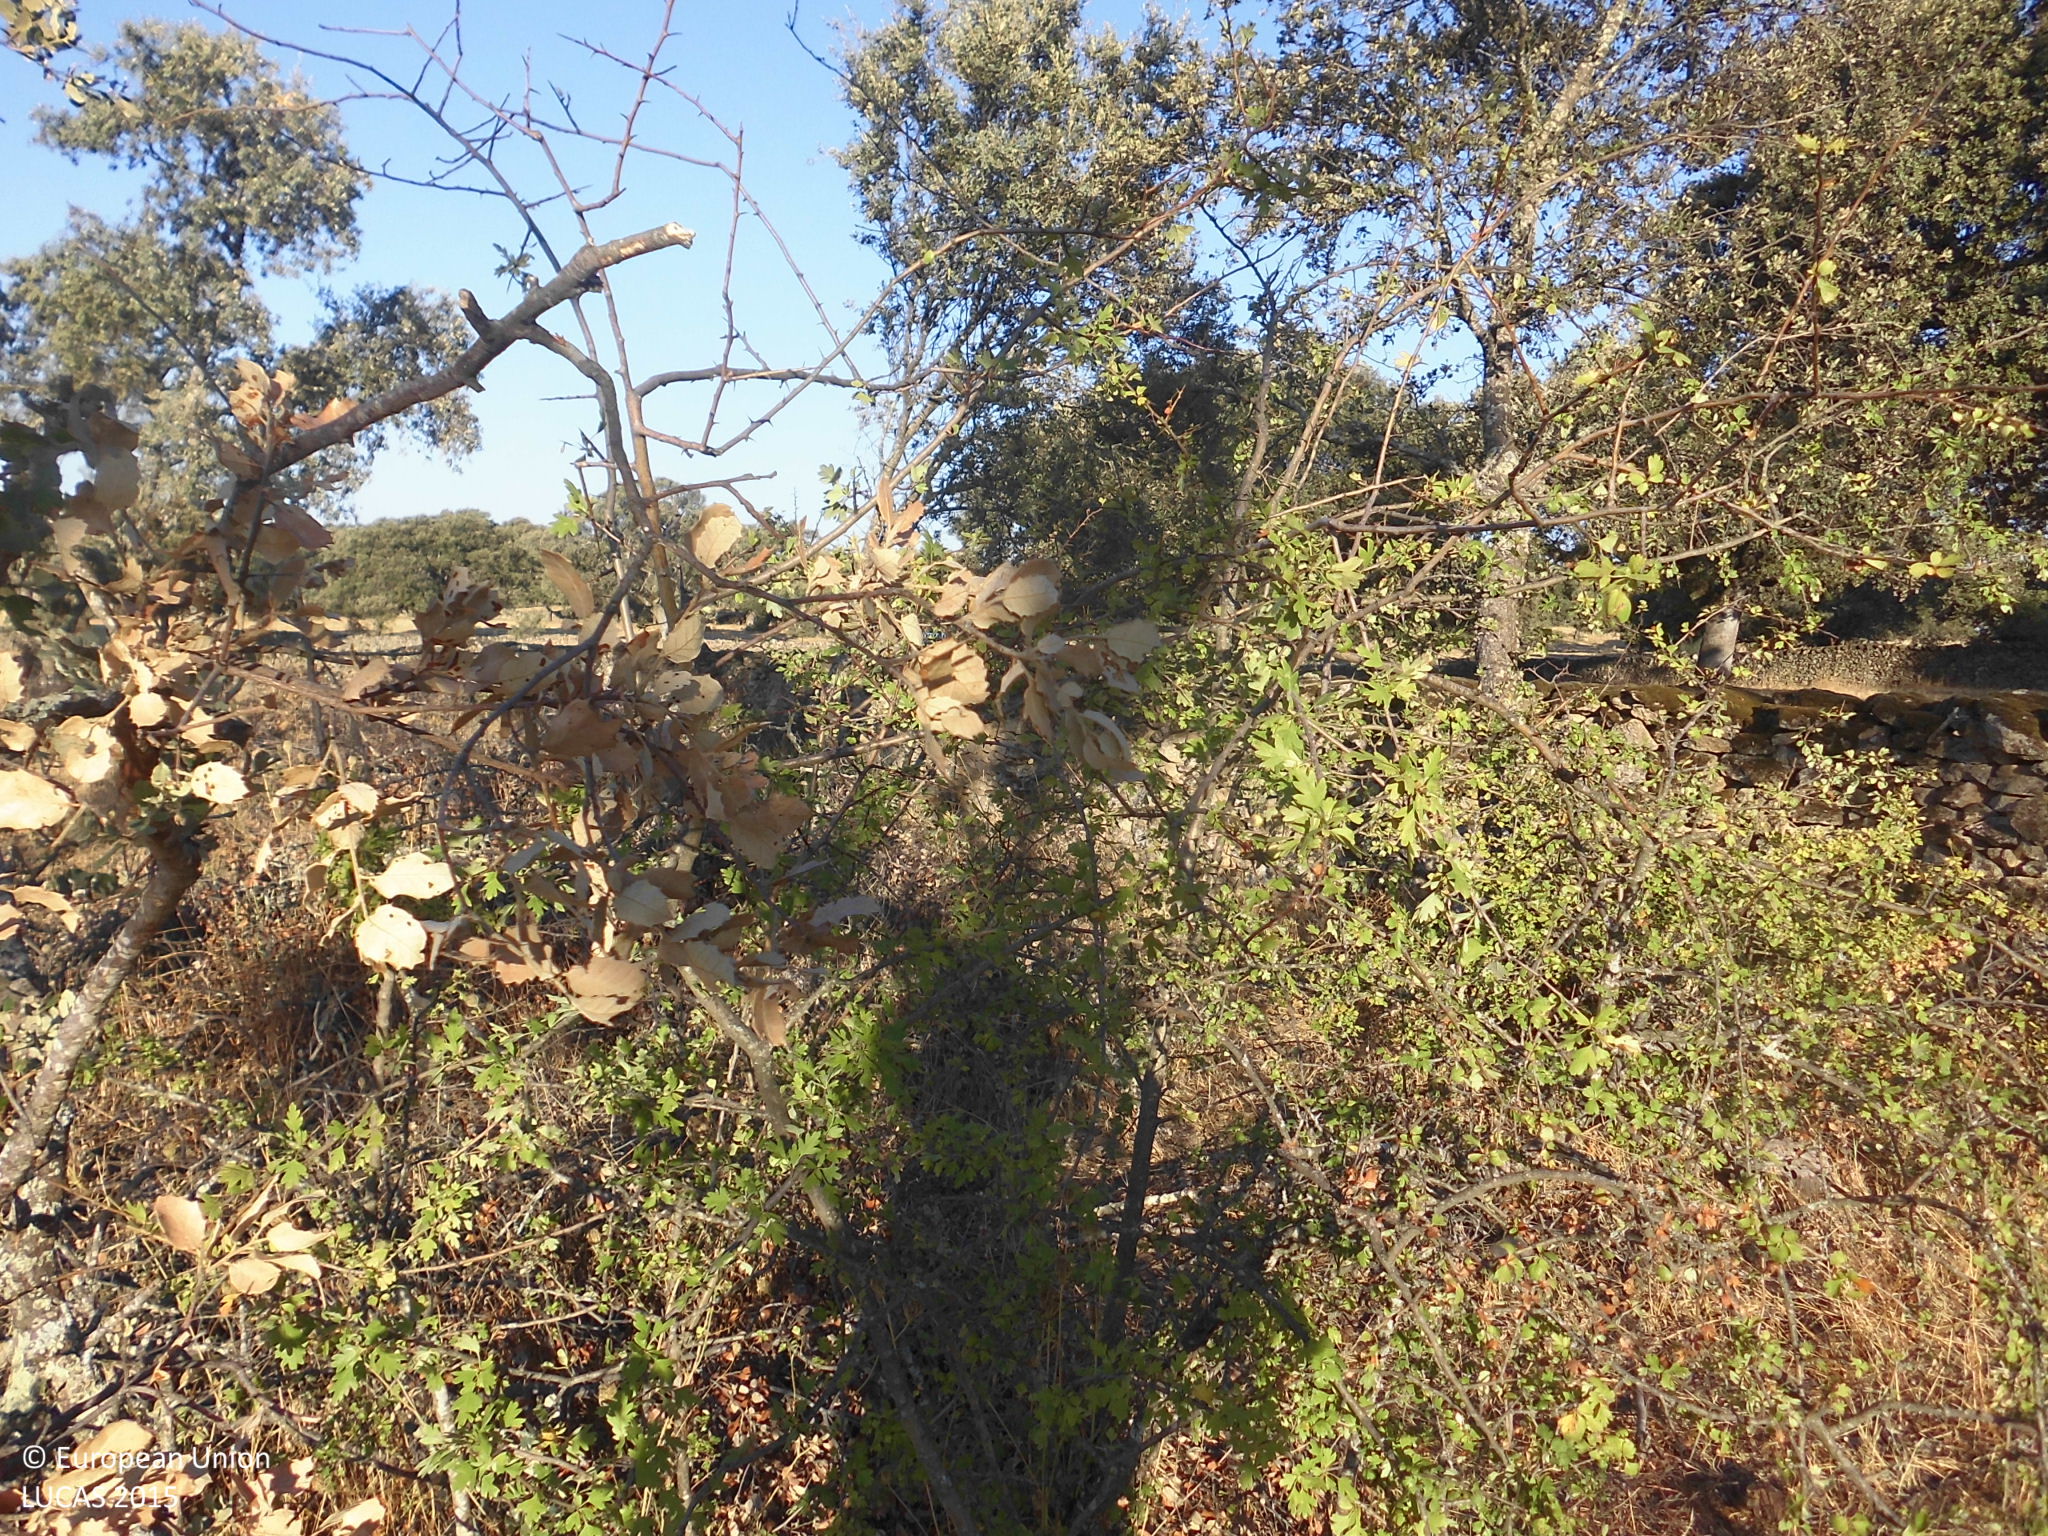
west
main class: Woodland
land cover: Broadleaved woodland
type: broadleaved evergreen forest
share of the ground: 25 - 50 %
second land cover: Grassland without tree/shrub cover
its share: > 75 %
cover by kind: herbaceous plants 65 %, broadleaved forest trees 35 %
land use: Forestry
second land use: Agriculture (excluding fallow land and kitchen gardens)
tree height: > 5 m
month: July
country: ES
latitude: 40.1102
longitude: -6.1829
